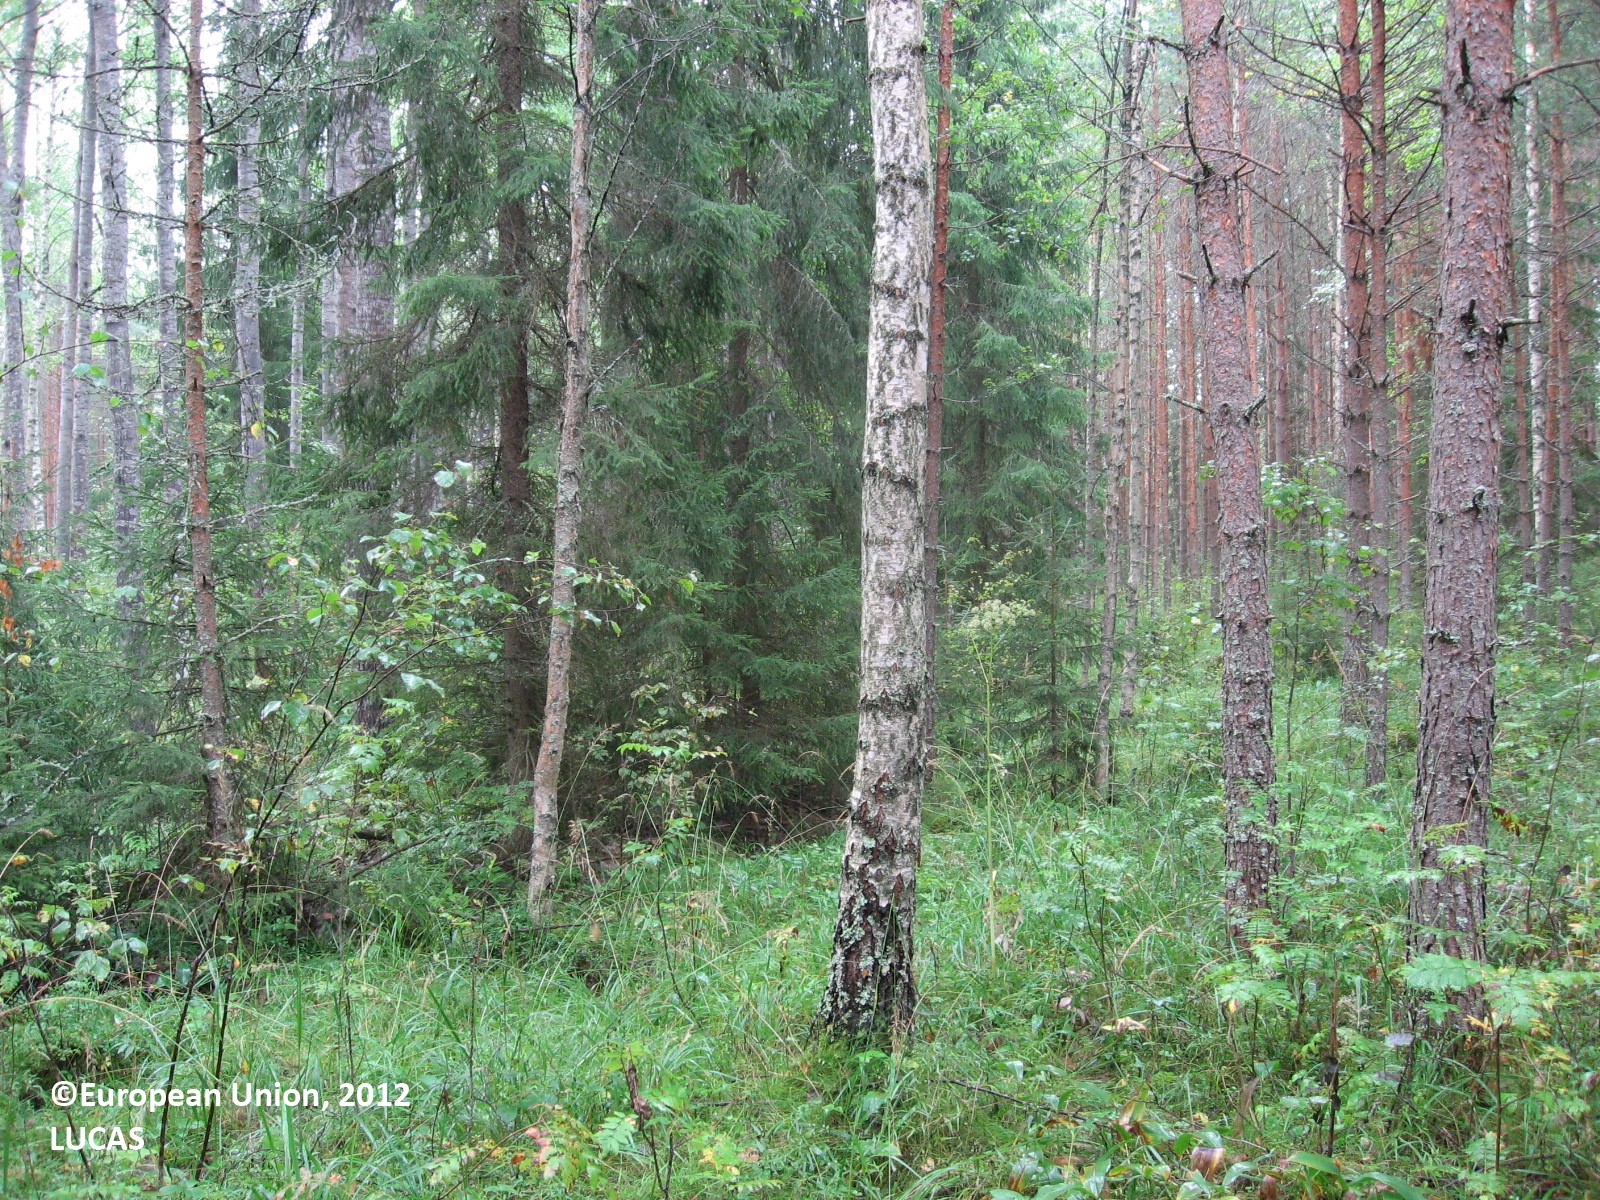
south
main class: Woodland
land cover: Pine dominated mixed woodland
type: boreal forest
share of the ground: 50 - 75 %
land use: Forestry
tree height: > 5 m
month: August
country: FI
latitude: 60.6305
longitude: 25.0890
